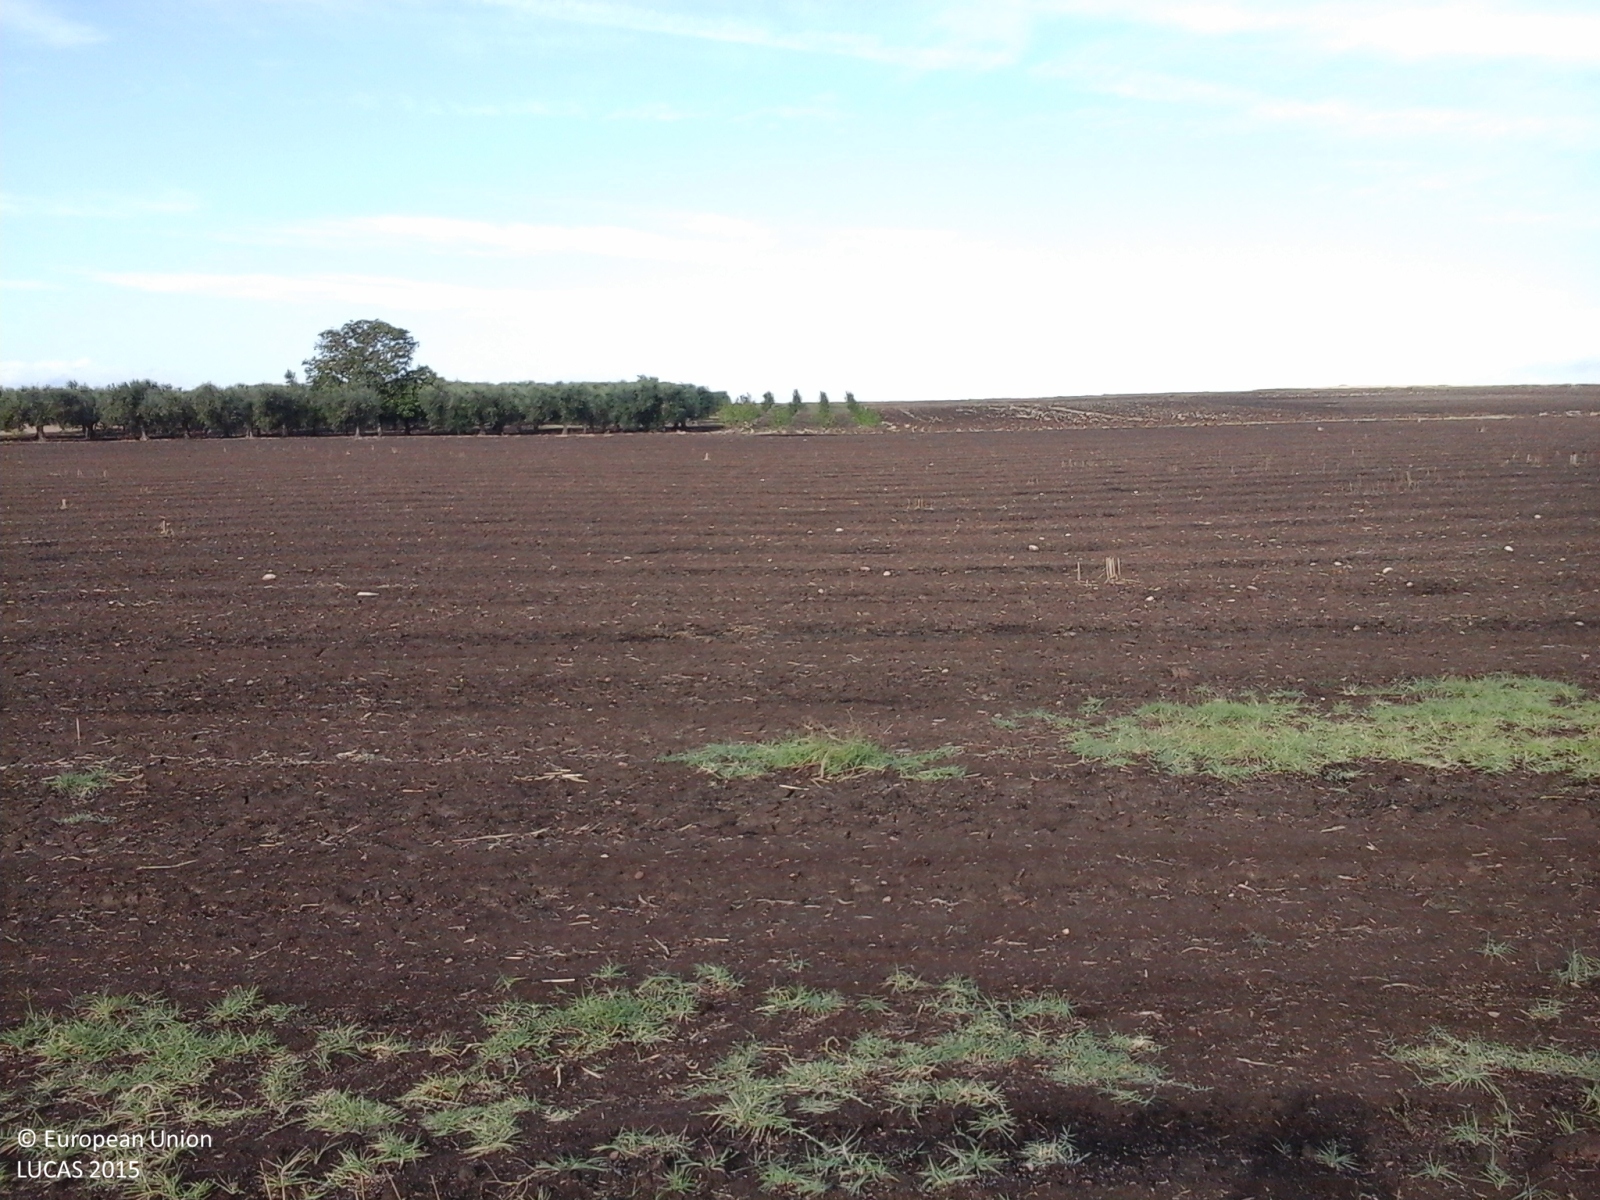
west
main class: Cropland
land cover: Durum wheat
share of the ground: > 75 %
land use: Agriculture (excluding fallow land and kitchen gardens)
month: September
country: IT
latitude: 41.7631
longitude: 15.1438
